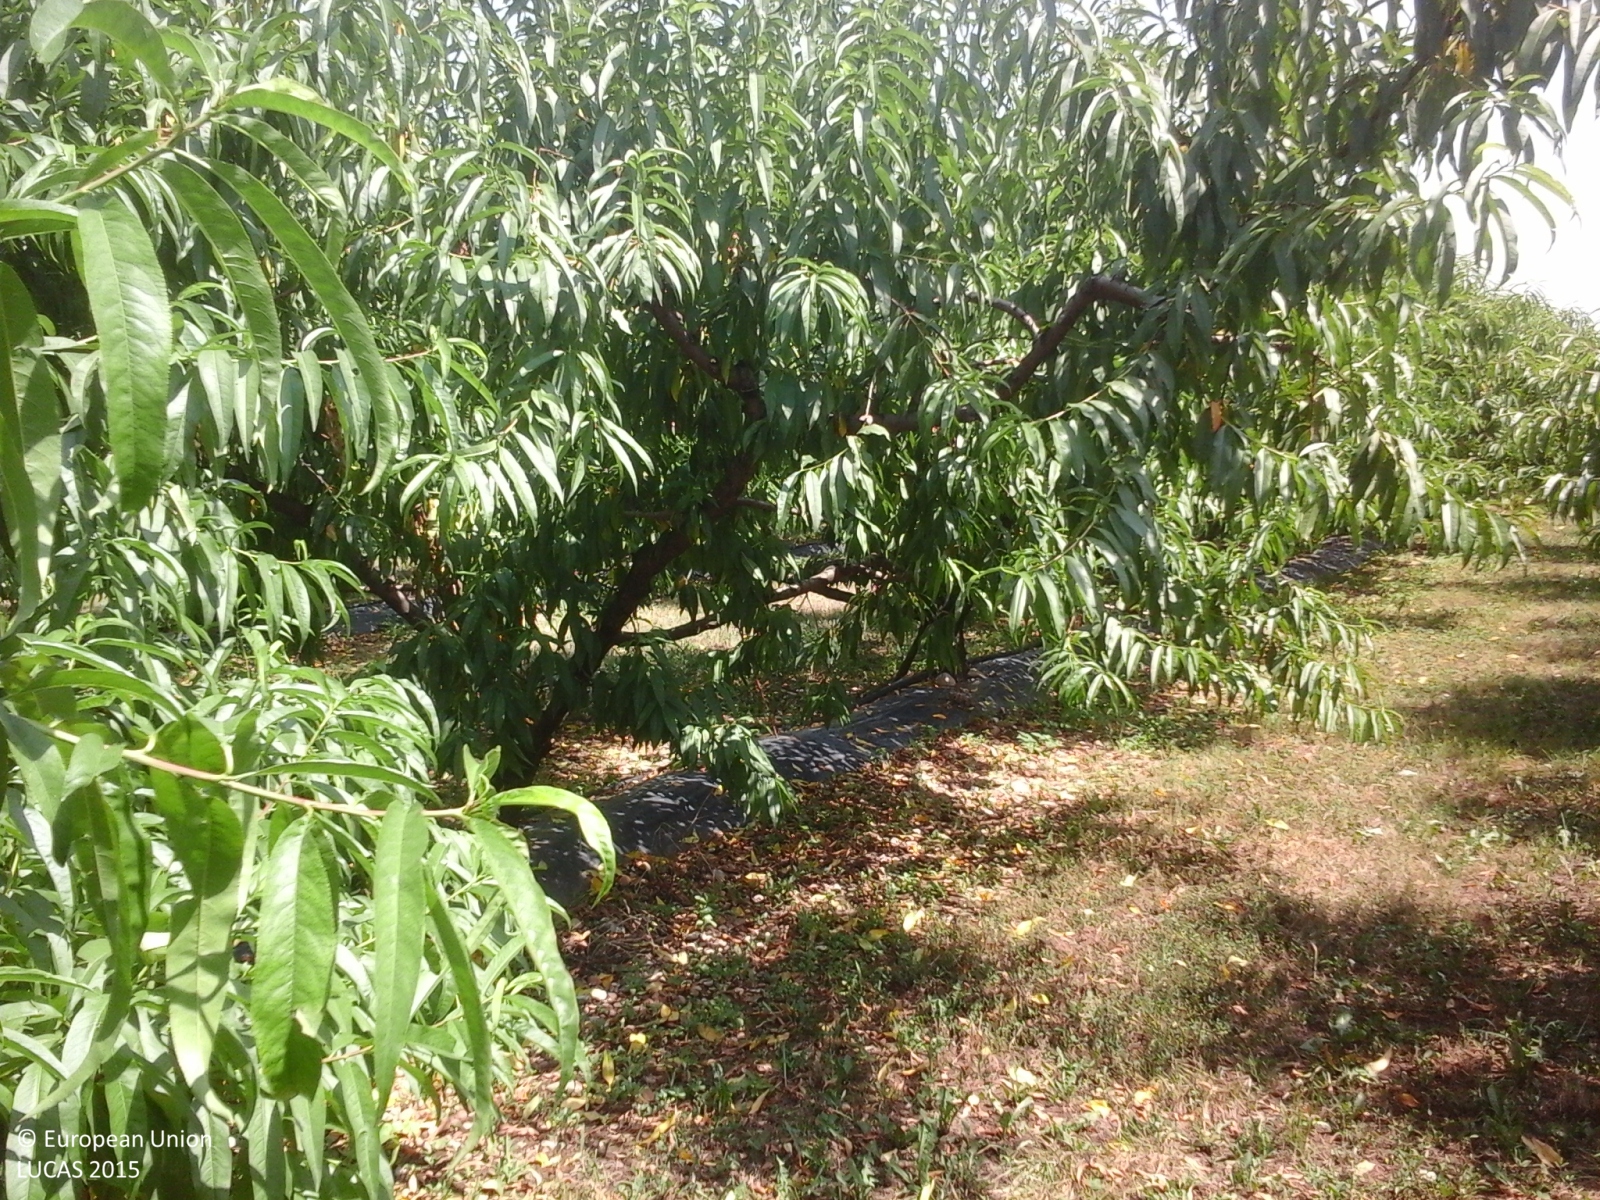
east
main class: Cropland
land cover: Other fruit trees and berries
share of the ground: > 75 %
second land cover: Grassland without tree/shrub cover
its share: > 75 %
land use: Agriculture (excluding fallow land and kitchen gardens)
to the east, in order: Other fruit trees and berries; Grassland without tree/shrub cover; Other bare soil; Other fruit trees and berries; Ditches and canals; Other fruit trees and berries
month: July
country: IT
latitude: 45.2854
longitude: 10.7508
